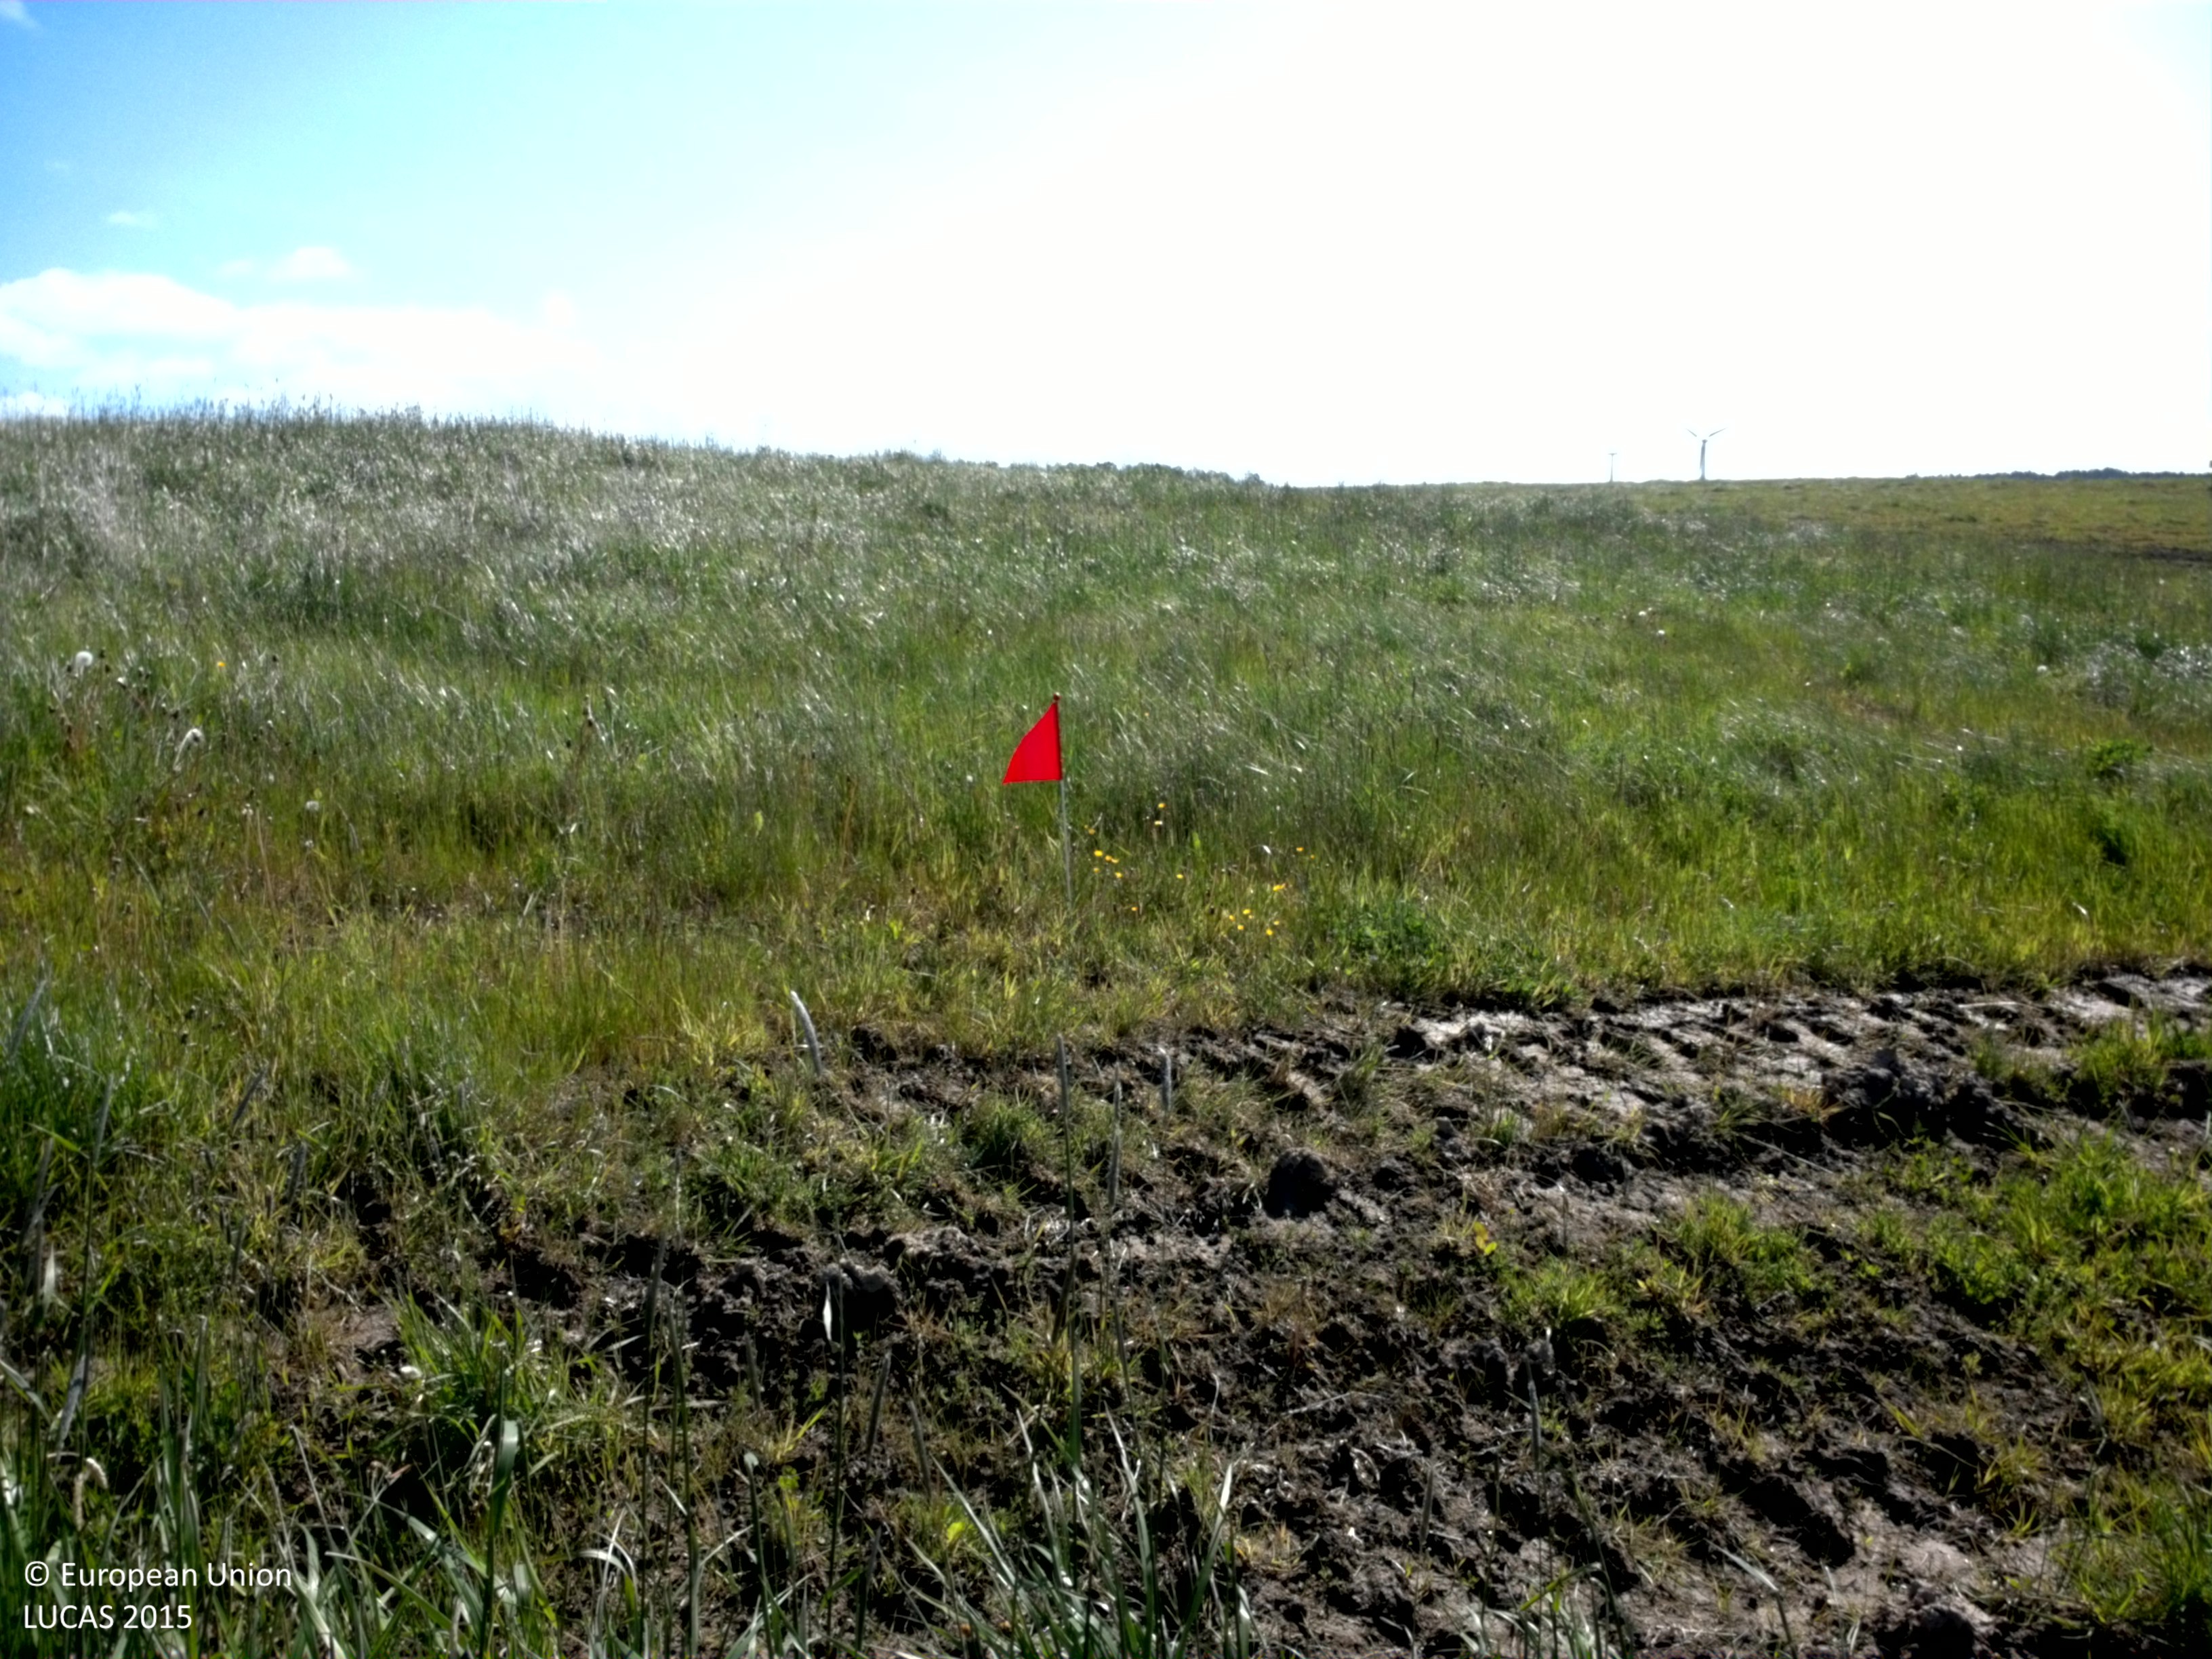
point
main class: Grassland
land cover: Grassland without tree/shrub cover
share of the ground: > 75 %
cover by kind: herbaceous plants 100 %
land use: Community services
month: June
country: SE
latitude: 58.3429
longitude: 13.9059
